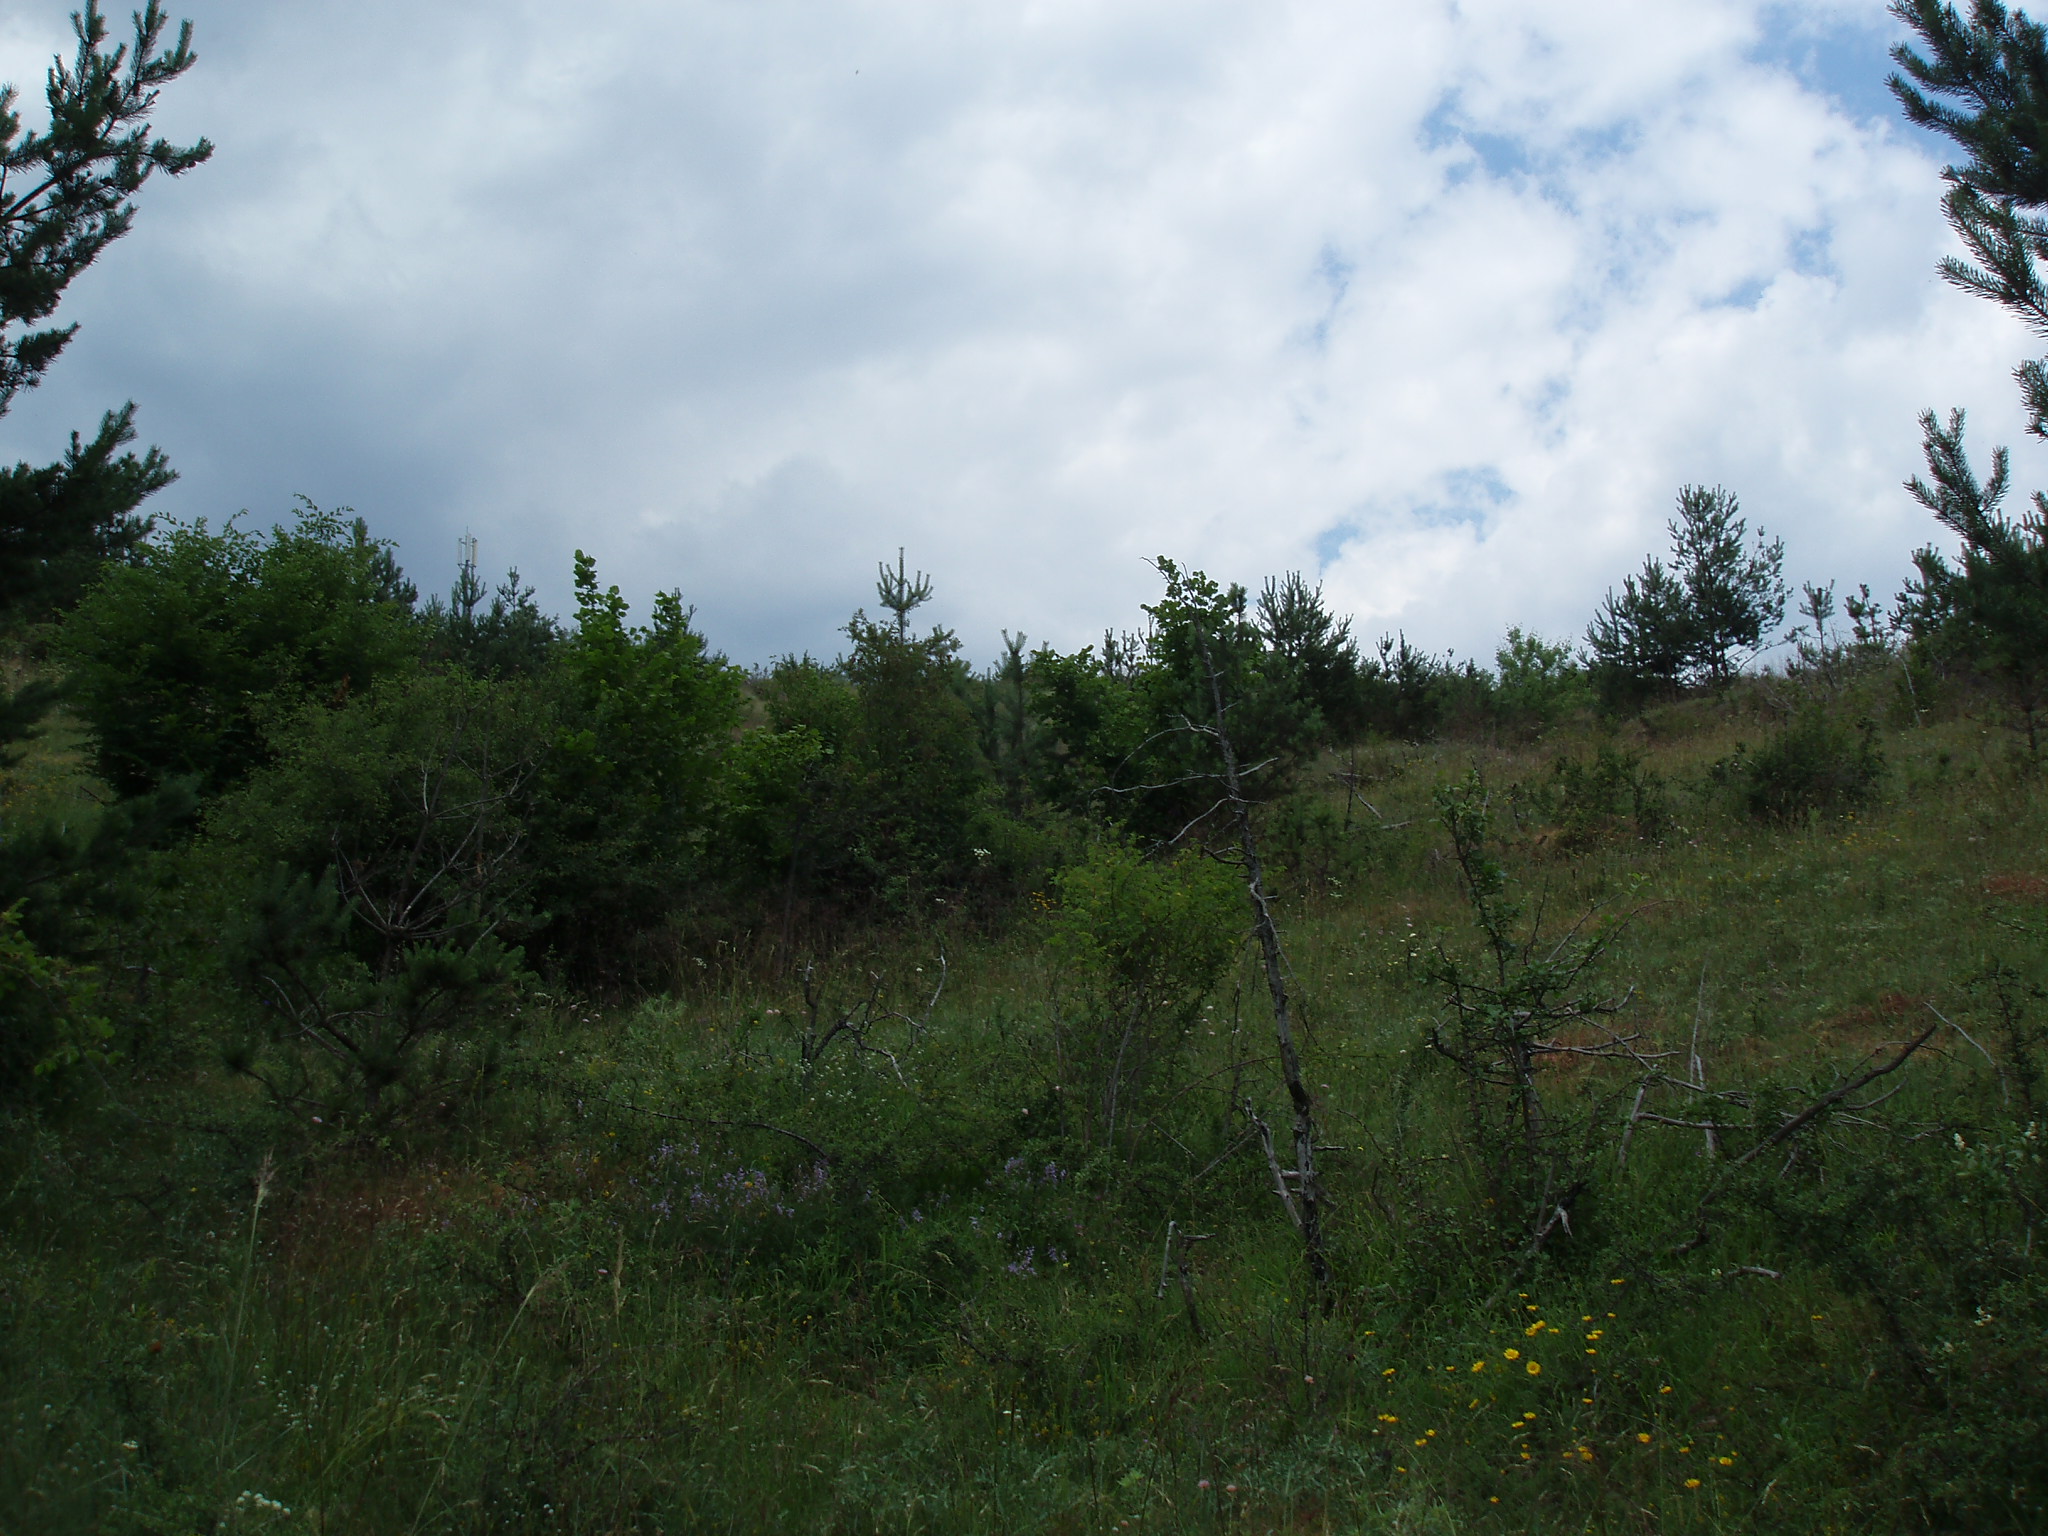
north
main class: Grassland
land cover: Grassland with sparse tree/shrub cover
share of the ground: > 75 %
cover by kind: herbaceous plants 90 %, broadleaved forest trees 5 %, shrubs 5 %
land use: Agriculture (excluding fallow land and kitchen gardens)
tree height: > 5 m
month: July
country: BG
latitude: 41.9108
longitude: 23.4951
